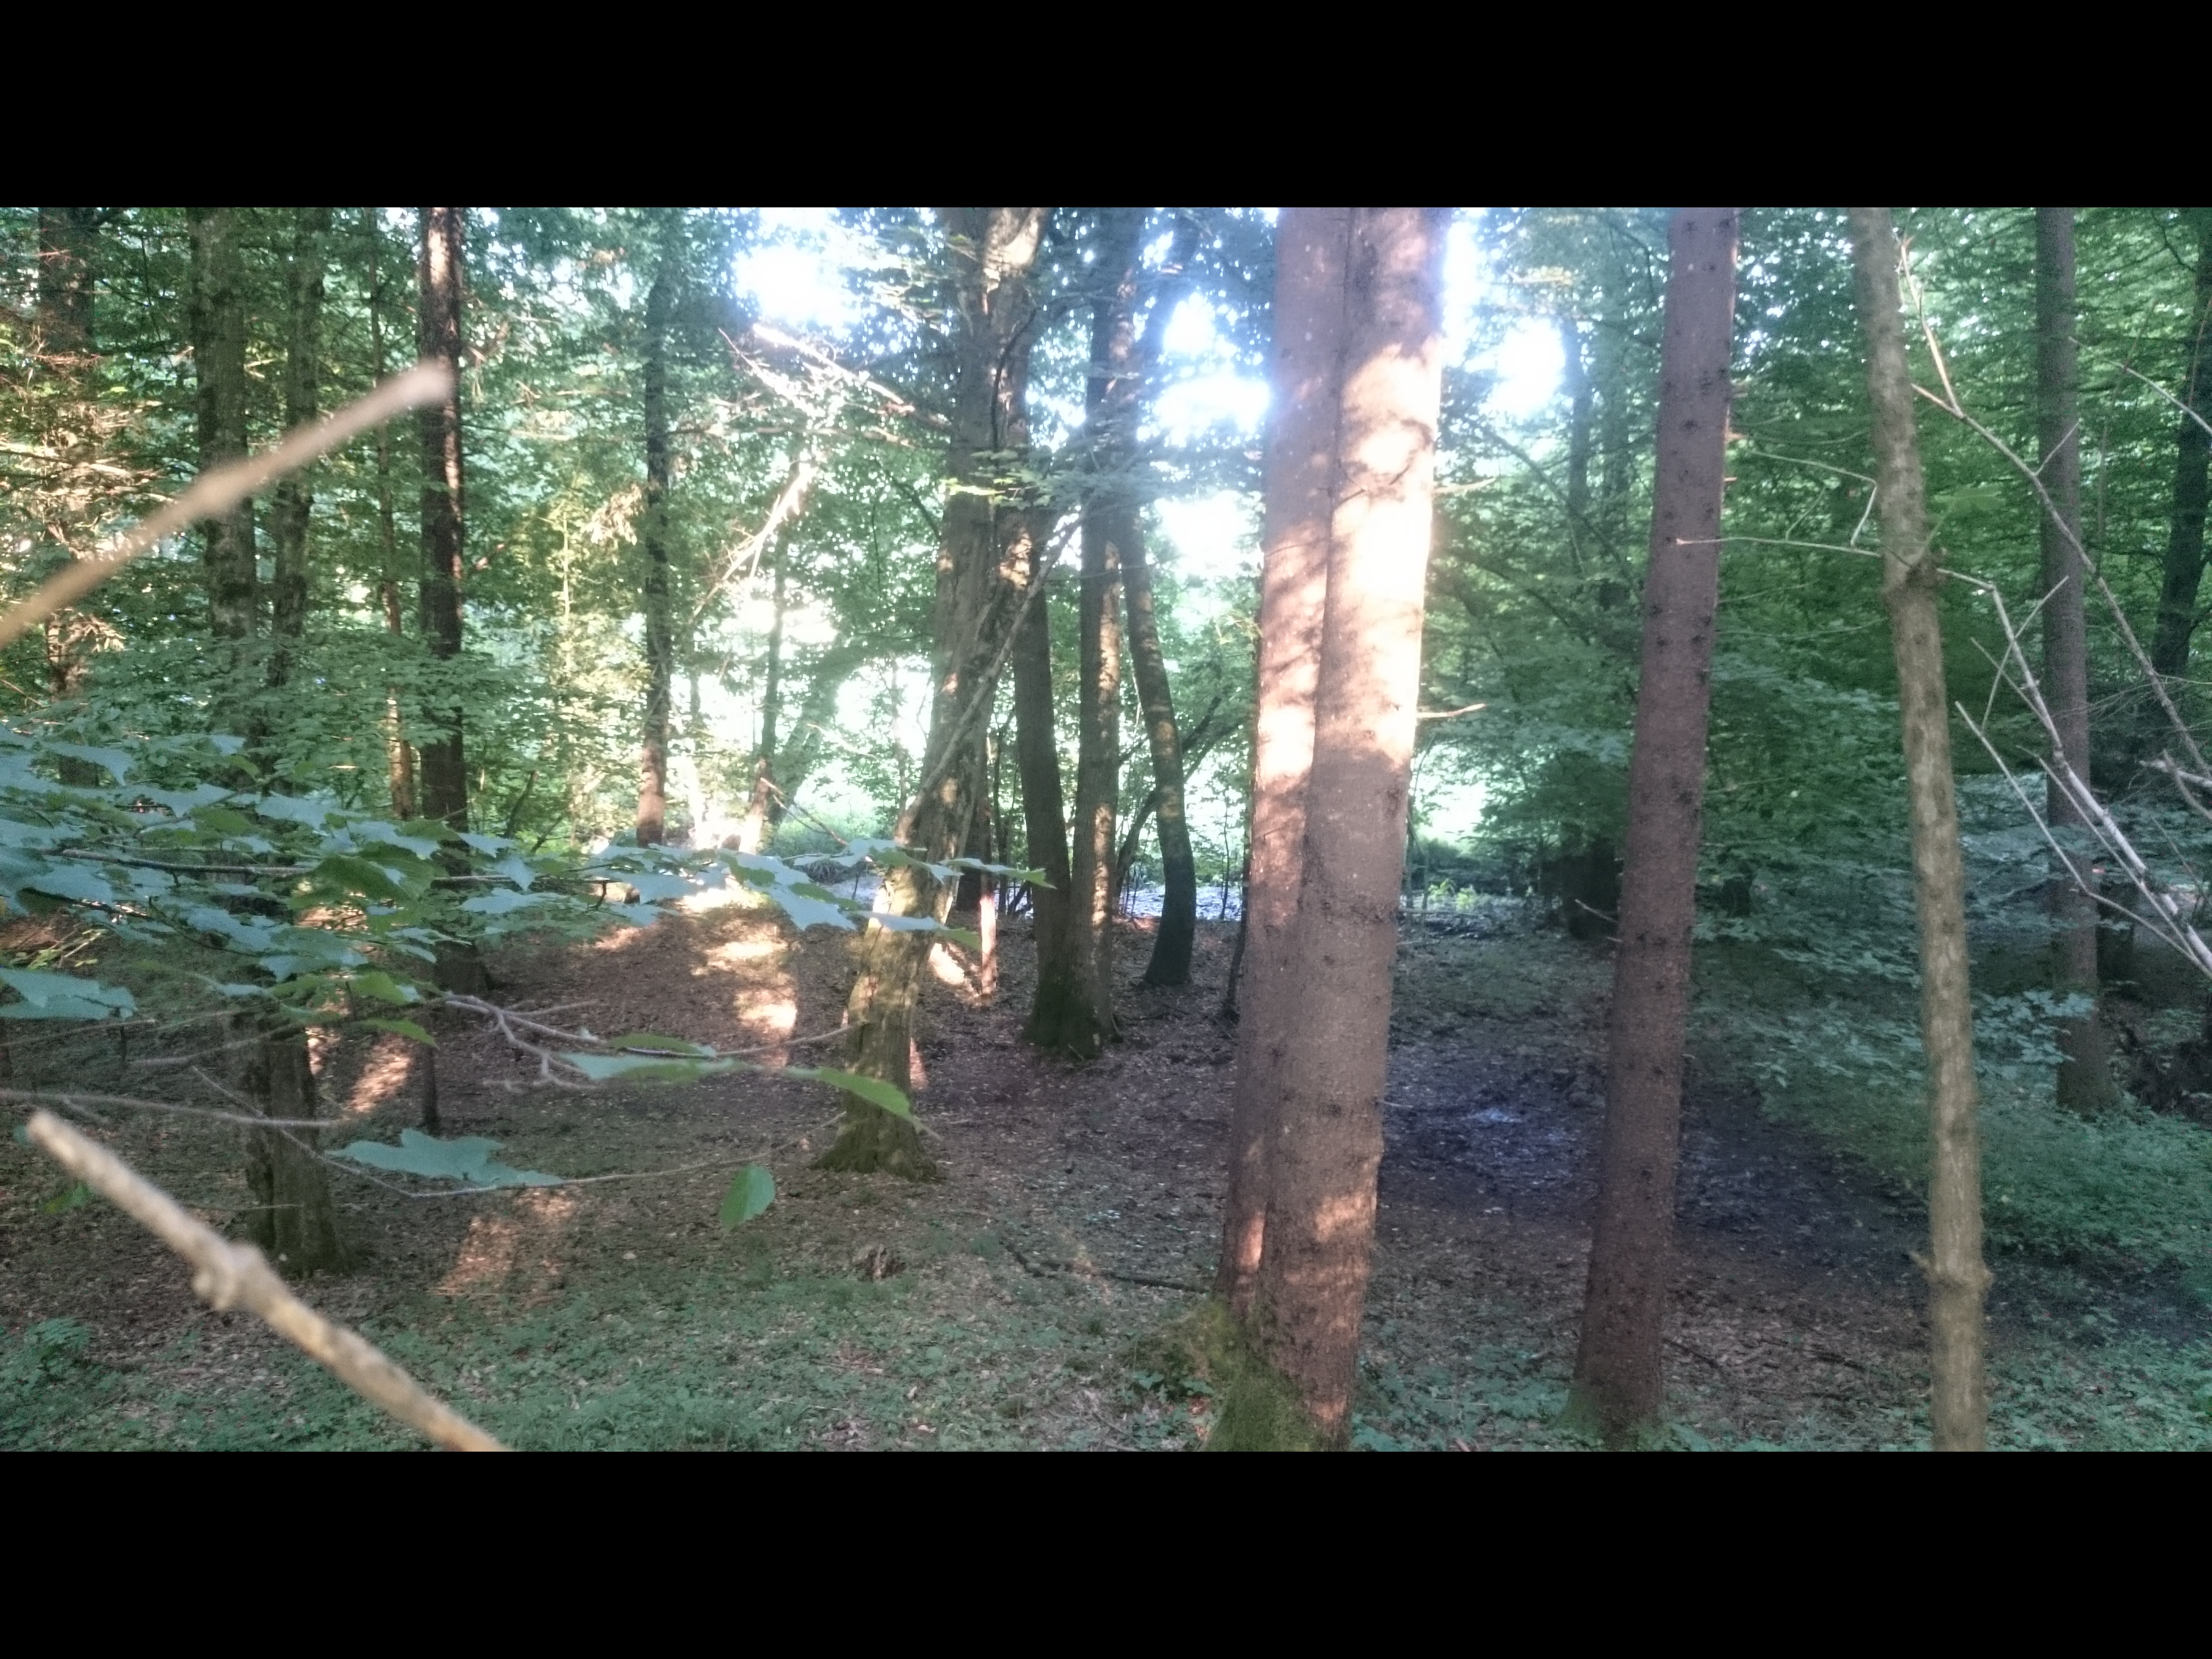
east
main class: Woodland
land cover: Spruce dominated mixed woodland
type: hemiboreal forest and nemoral coniferous forest and mixed broadleaved-coniferous forest
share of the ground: > 75 %
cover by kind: coniferous forest trees 45 %, broadleaved forest trees 45 %, herbaceous plants 10 %
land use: Forestry
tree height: > 5 m
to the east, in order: Spruce dominated mixed woodland; Rivers and streams; Broadleaved woodland; Grassland without tree/shrub cover; Electric lines; Grassland without tree/shrub cover; Spruce dominated mixed woodland; Tracks; Spruce dominated mixed woodland
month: July
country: AT
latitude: 47.2285
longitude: 15.6932
